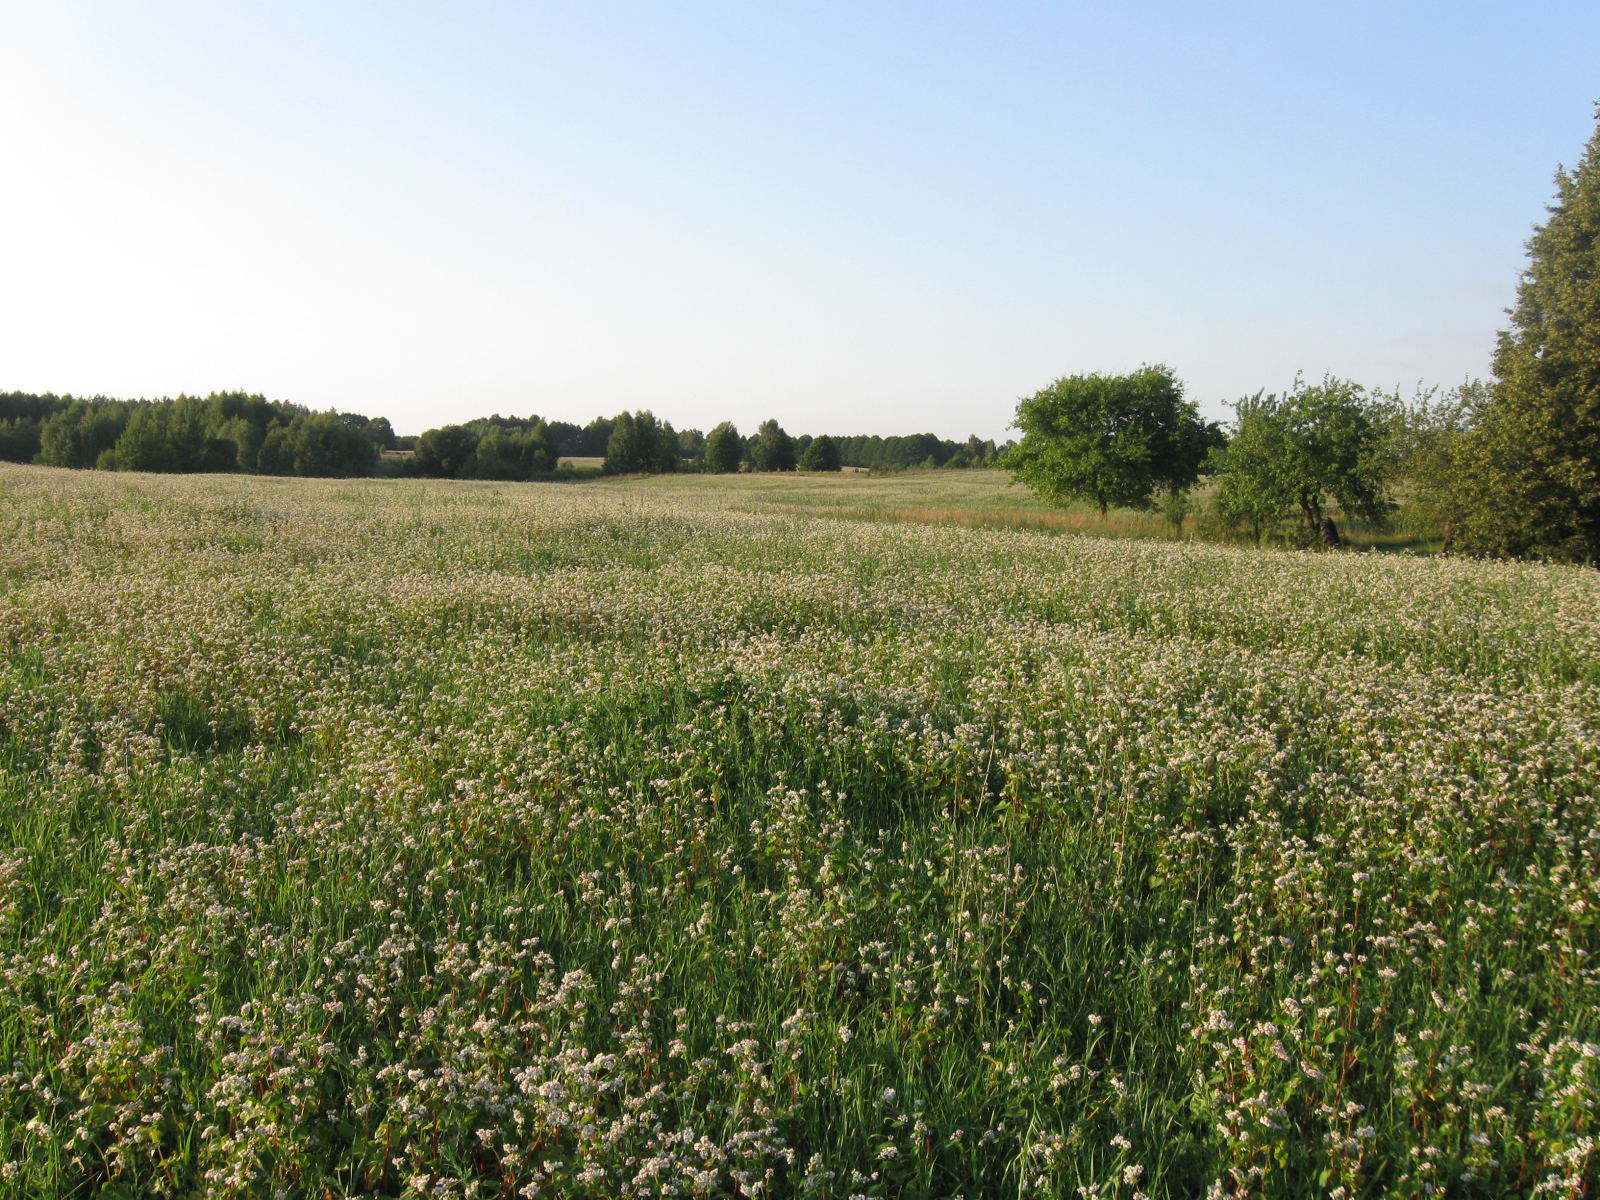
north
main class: Cropland
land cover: Other cereals
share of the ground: > 75 %
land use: Agriculture (excluding fallow land and kitchen gardens)
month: July
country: LT
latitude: 54.0746
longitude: 23.7352
